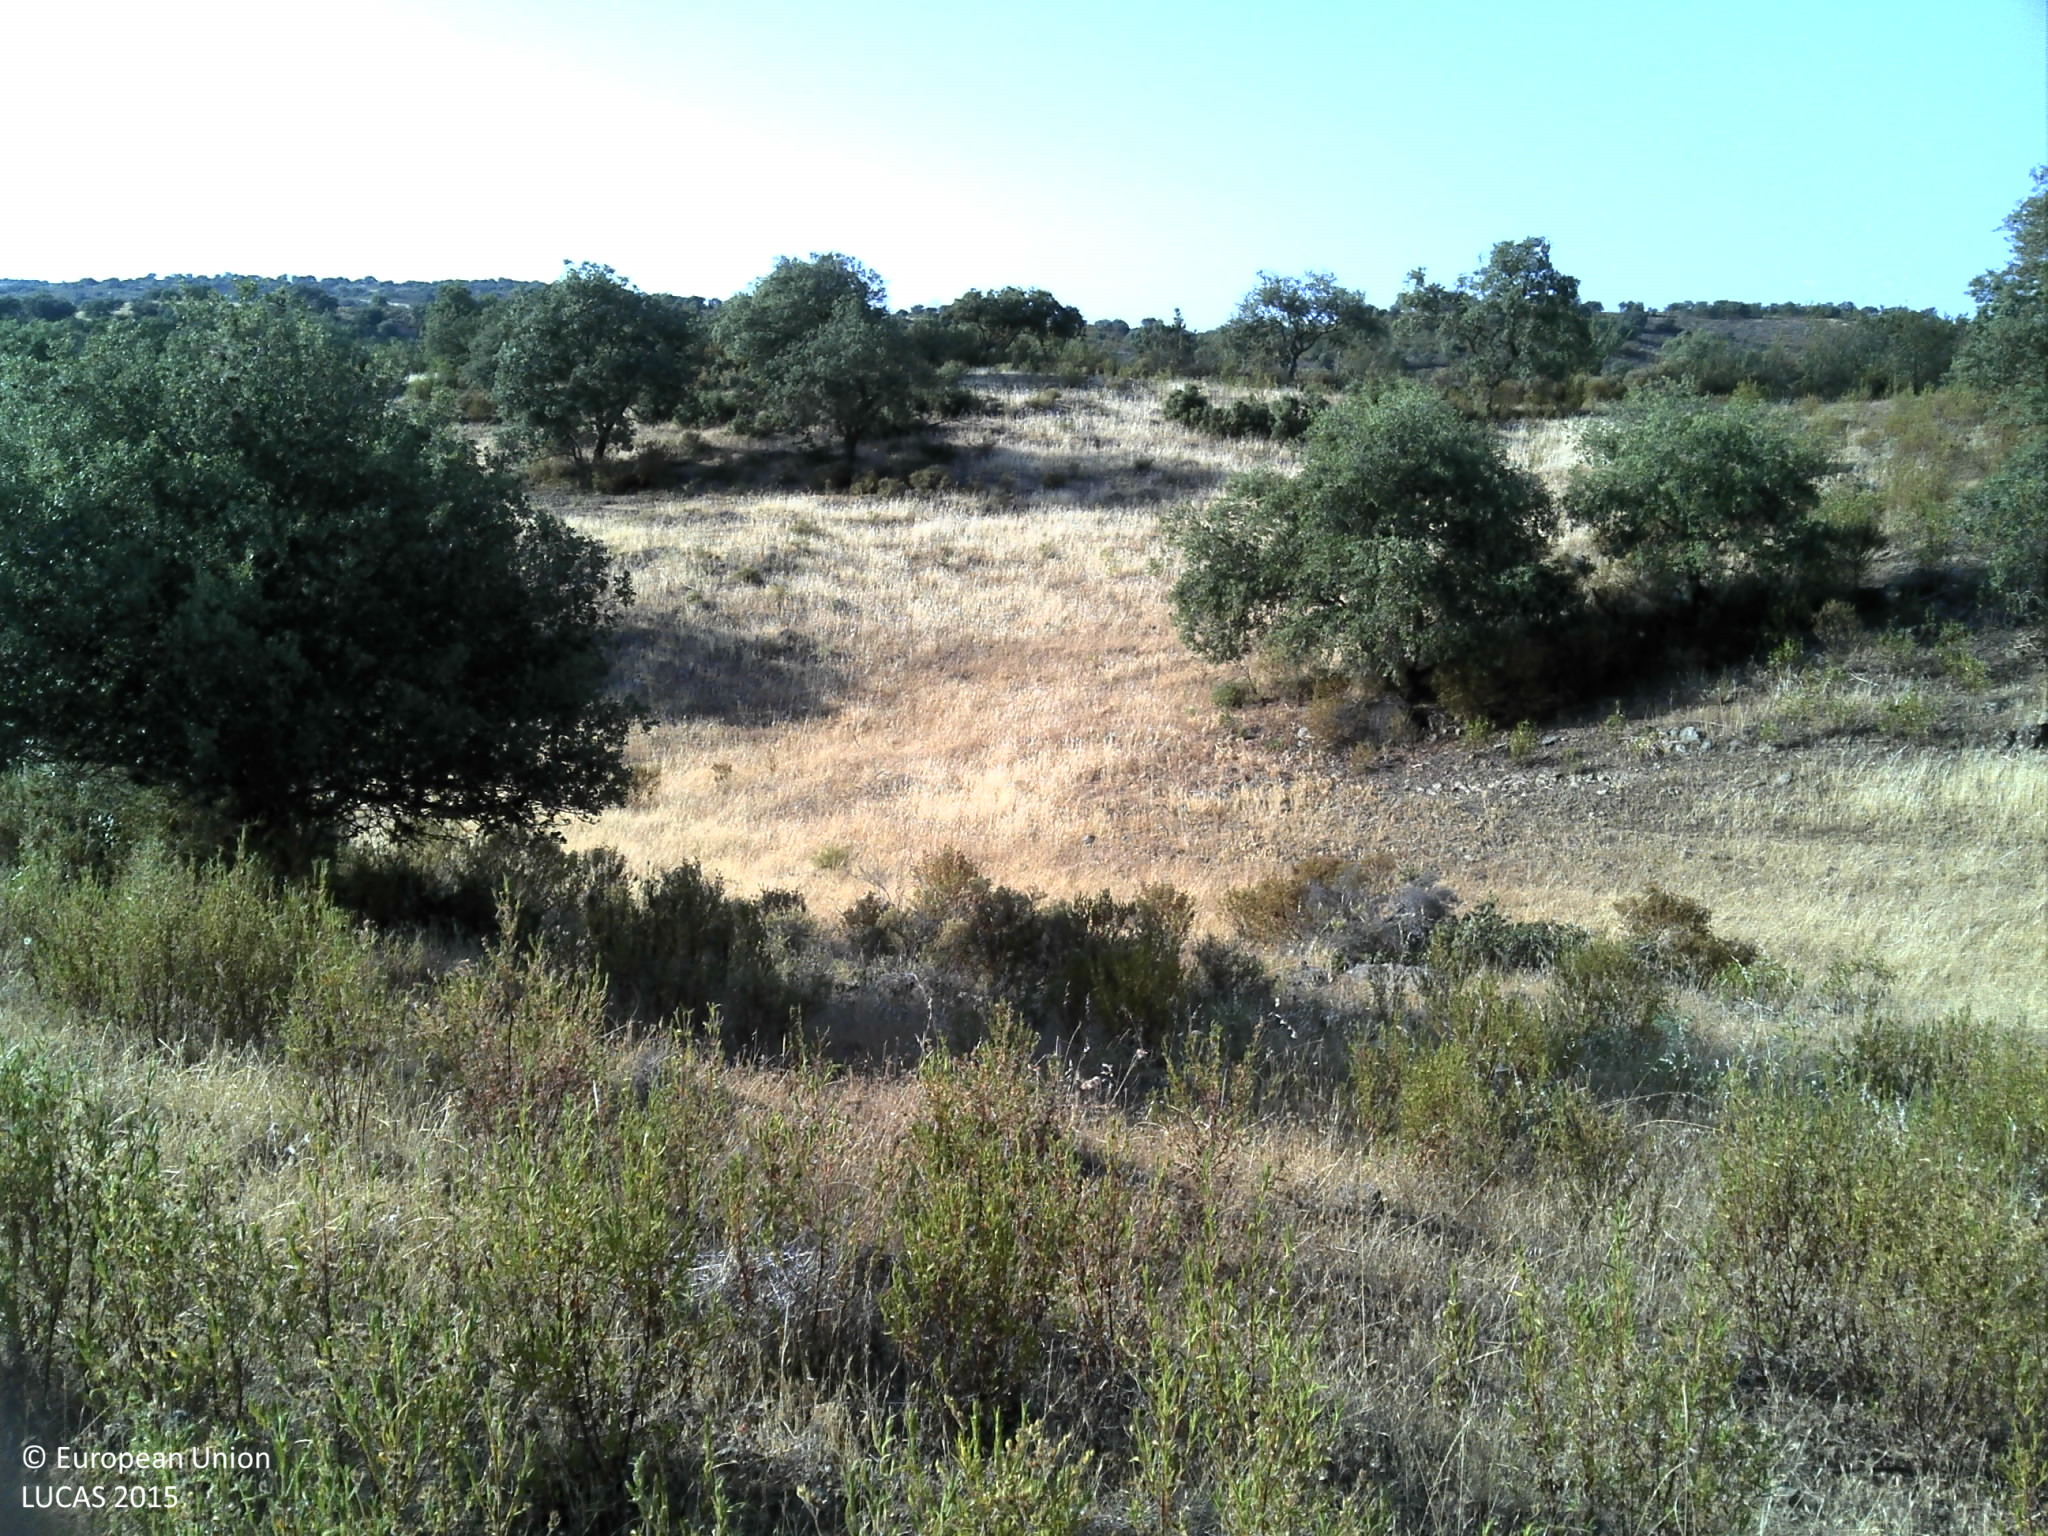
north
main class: Woodland
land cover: Broadleaved woodland
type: broadleaved evergreen forest
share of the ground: 25 - 50 %
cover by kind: broadleaved forest trees 50 %, shrubs 25 %, herbaceous plants 15 %, unconsolidated bare surface 10 %
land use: Forestry
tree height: < 5 m
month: June
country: PT
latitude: 37.5942
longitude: -7.5791
